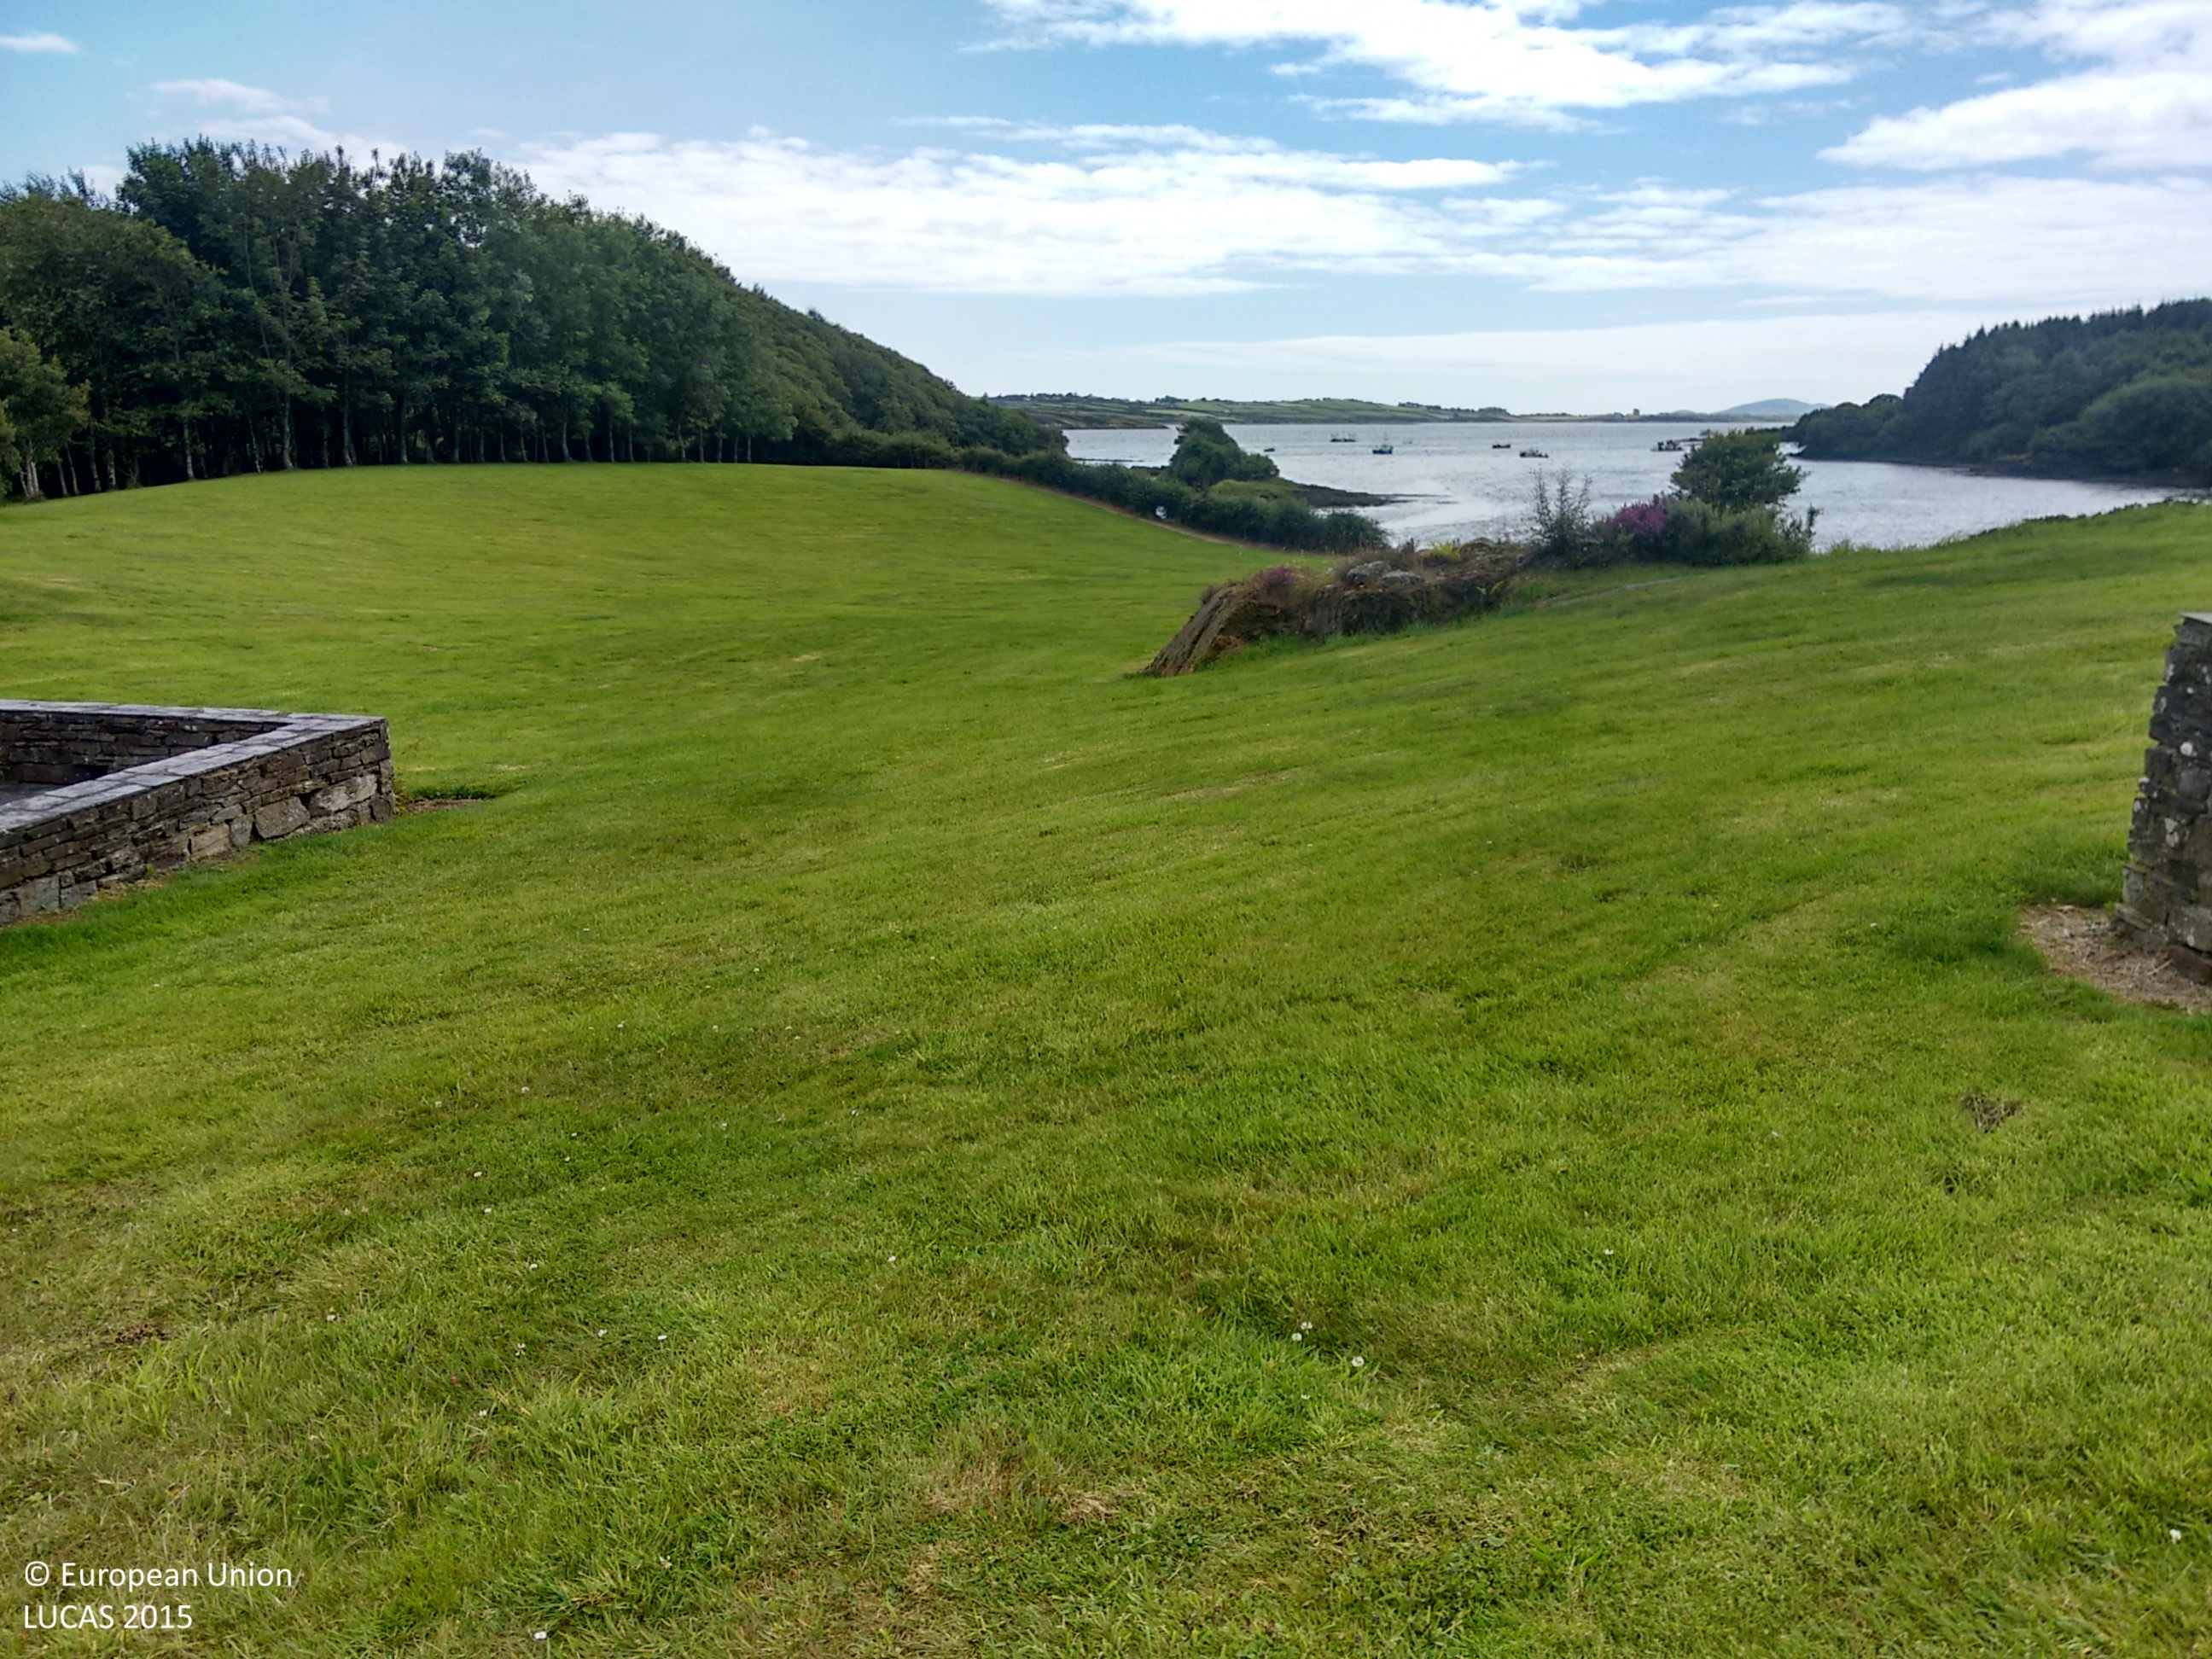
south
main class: Grassland
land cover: Grassland without tree/shrub cover
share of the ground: > 75 %
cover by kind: herbaceous plants 80 %
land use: Residential
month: July
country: IE
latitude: 51.5510
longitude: -9.3947
